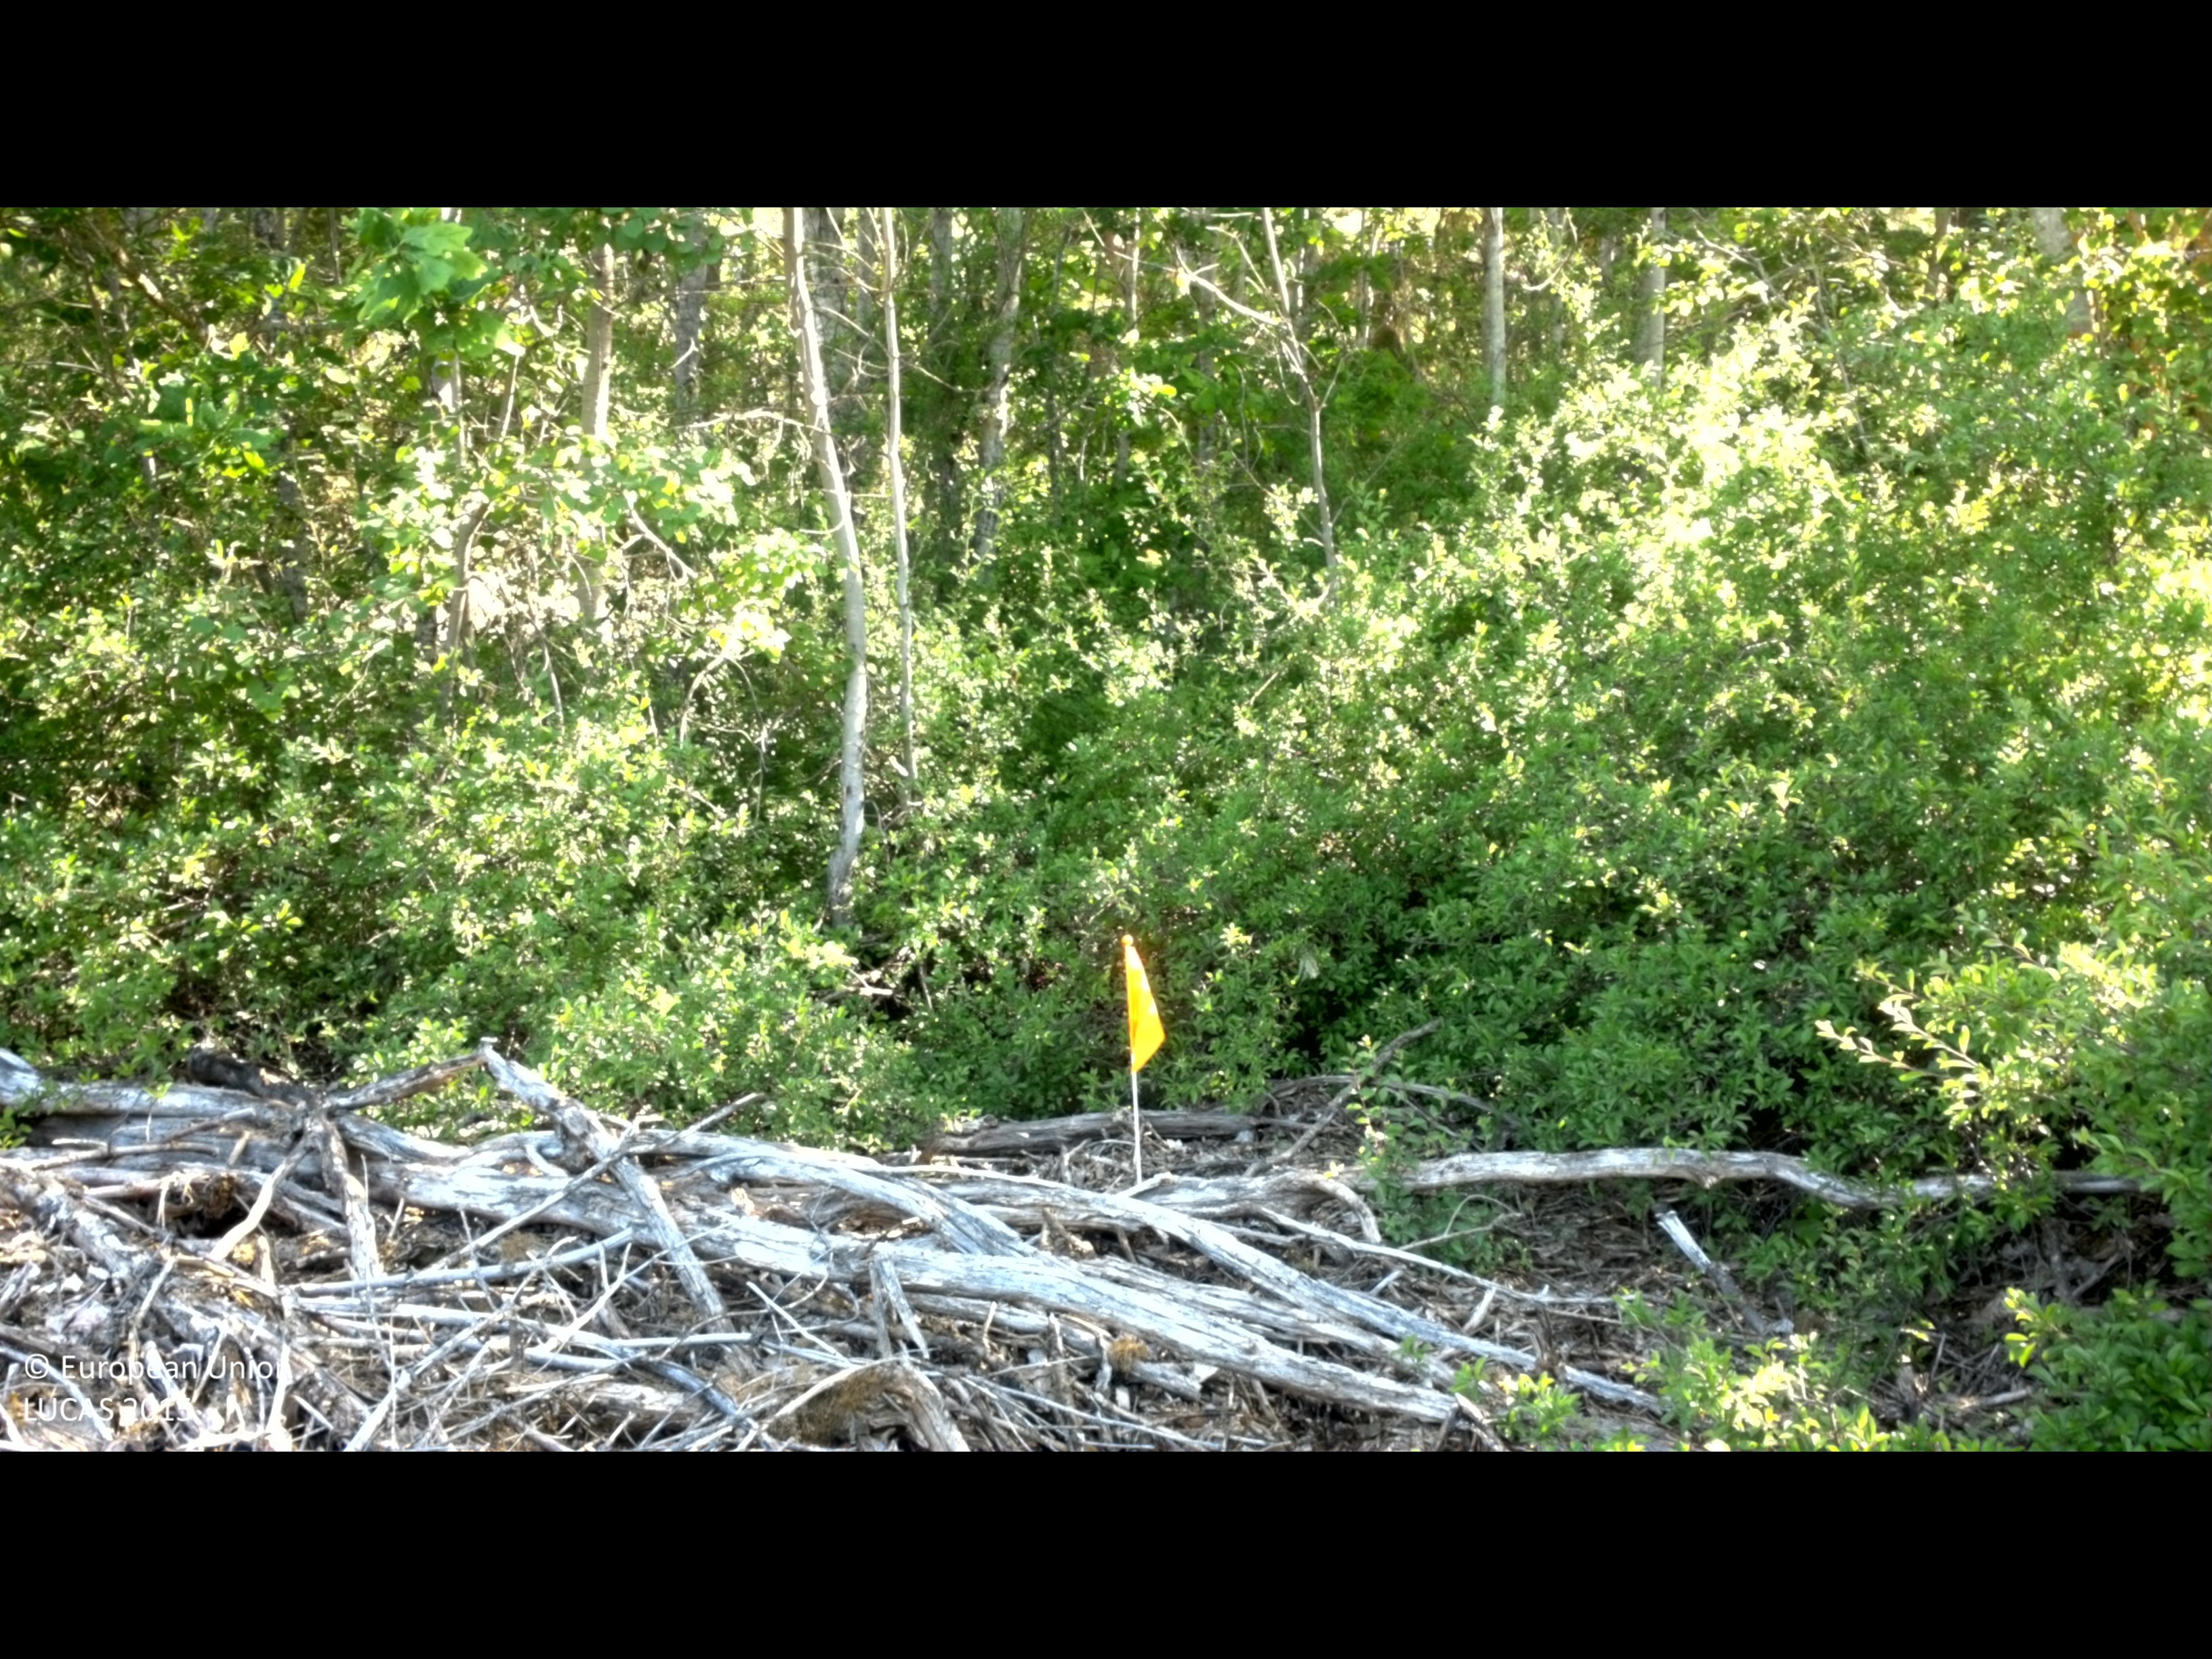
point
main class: Woodland
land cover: Broadleaved woodland
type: hemiboreal forest and nemoral coniferous forest and mixed broadleaved-coniferous forest
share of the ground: 25 - 50 %
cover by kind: shrubs 50 %, broadleaved forest trees 40 %, unconsolidated bare surface 10 %
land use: Forestry
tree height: > 5 m
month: June
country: SE
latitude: 57.6105
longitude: 16.5099
